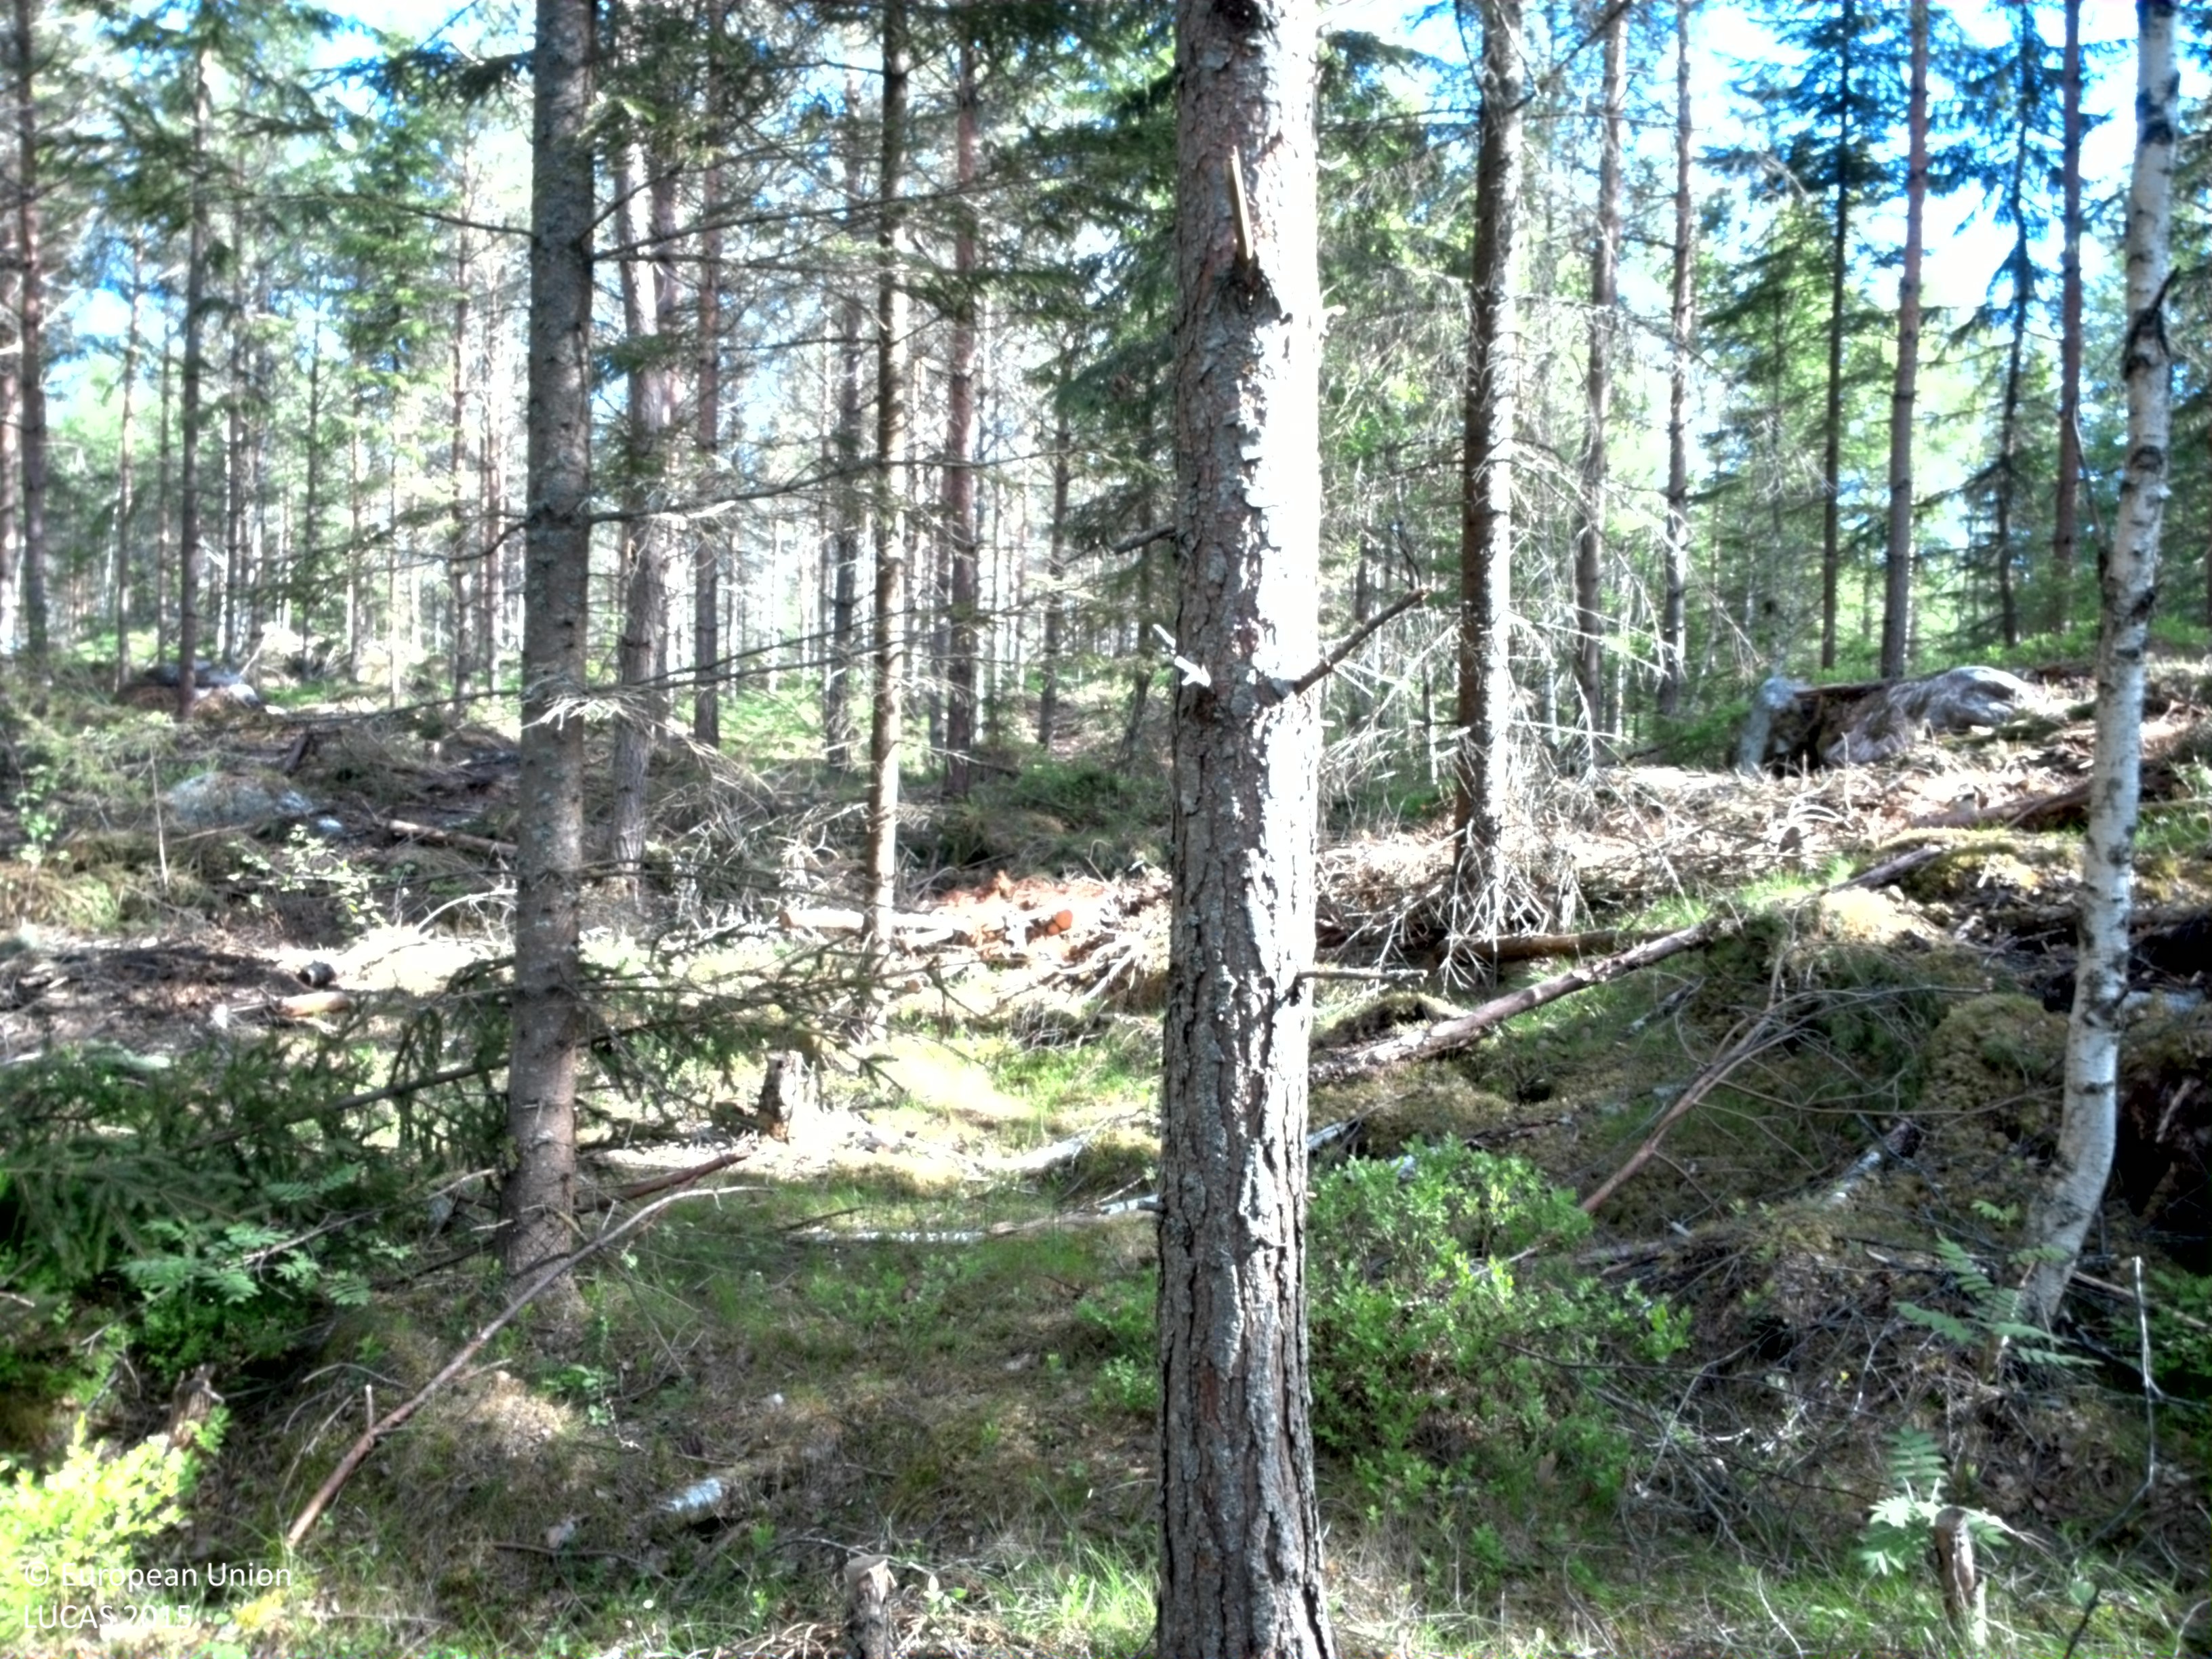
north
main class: Woodland
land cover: Other mixed woodland
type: boreal forest
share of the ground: > 75 %
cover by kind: coniferous forest trees 45 %, broadleaved forest trees 35 %, shrubs 10 %, herbaceous plants 10 %
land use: Forestry
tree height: > 5 m
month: June
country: SE
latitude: 58.6513
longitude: 14.4221
